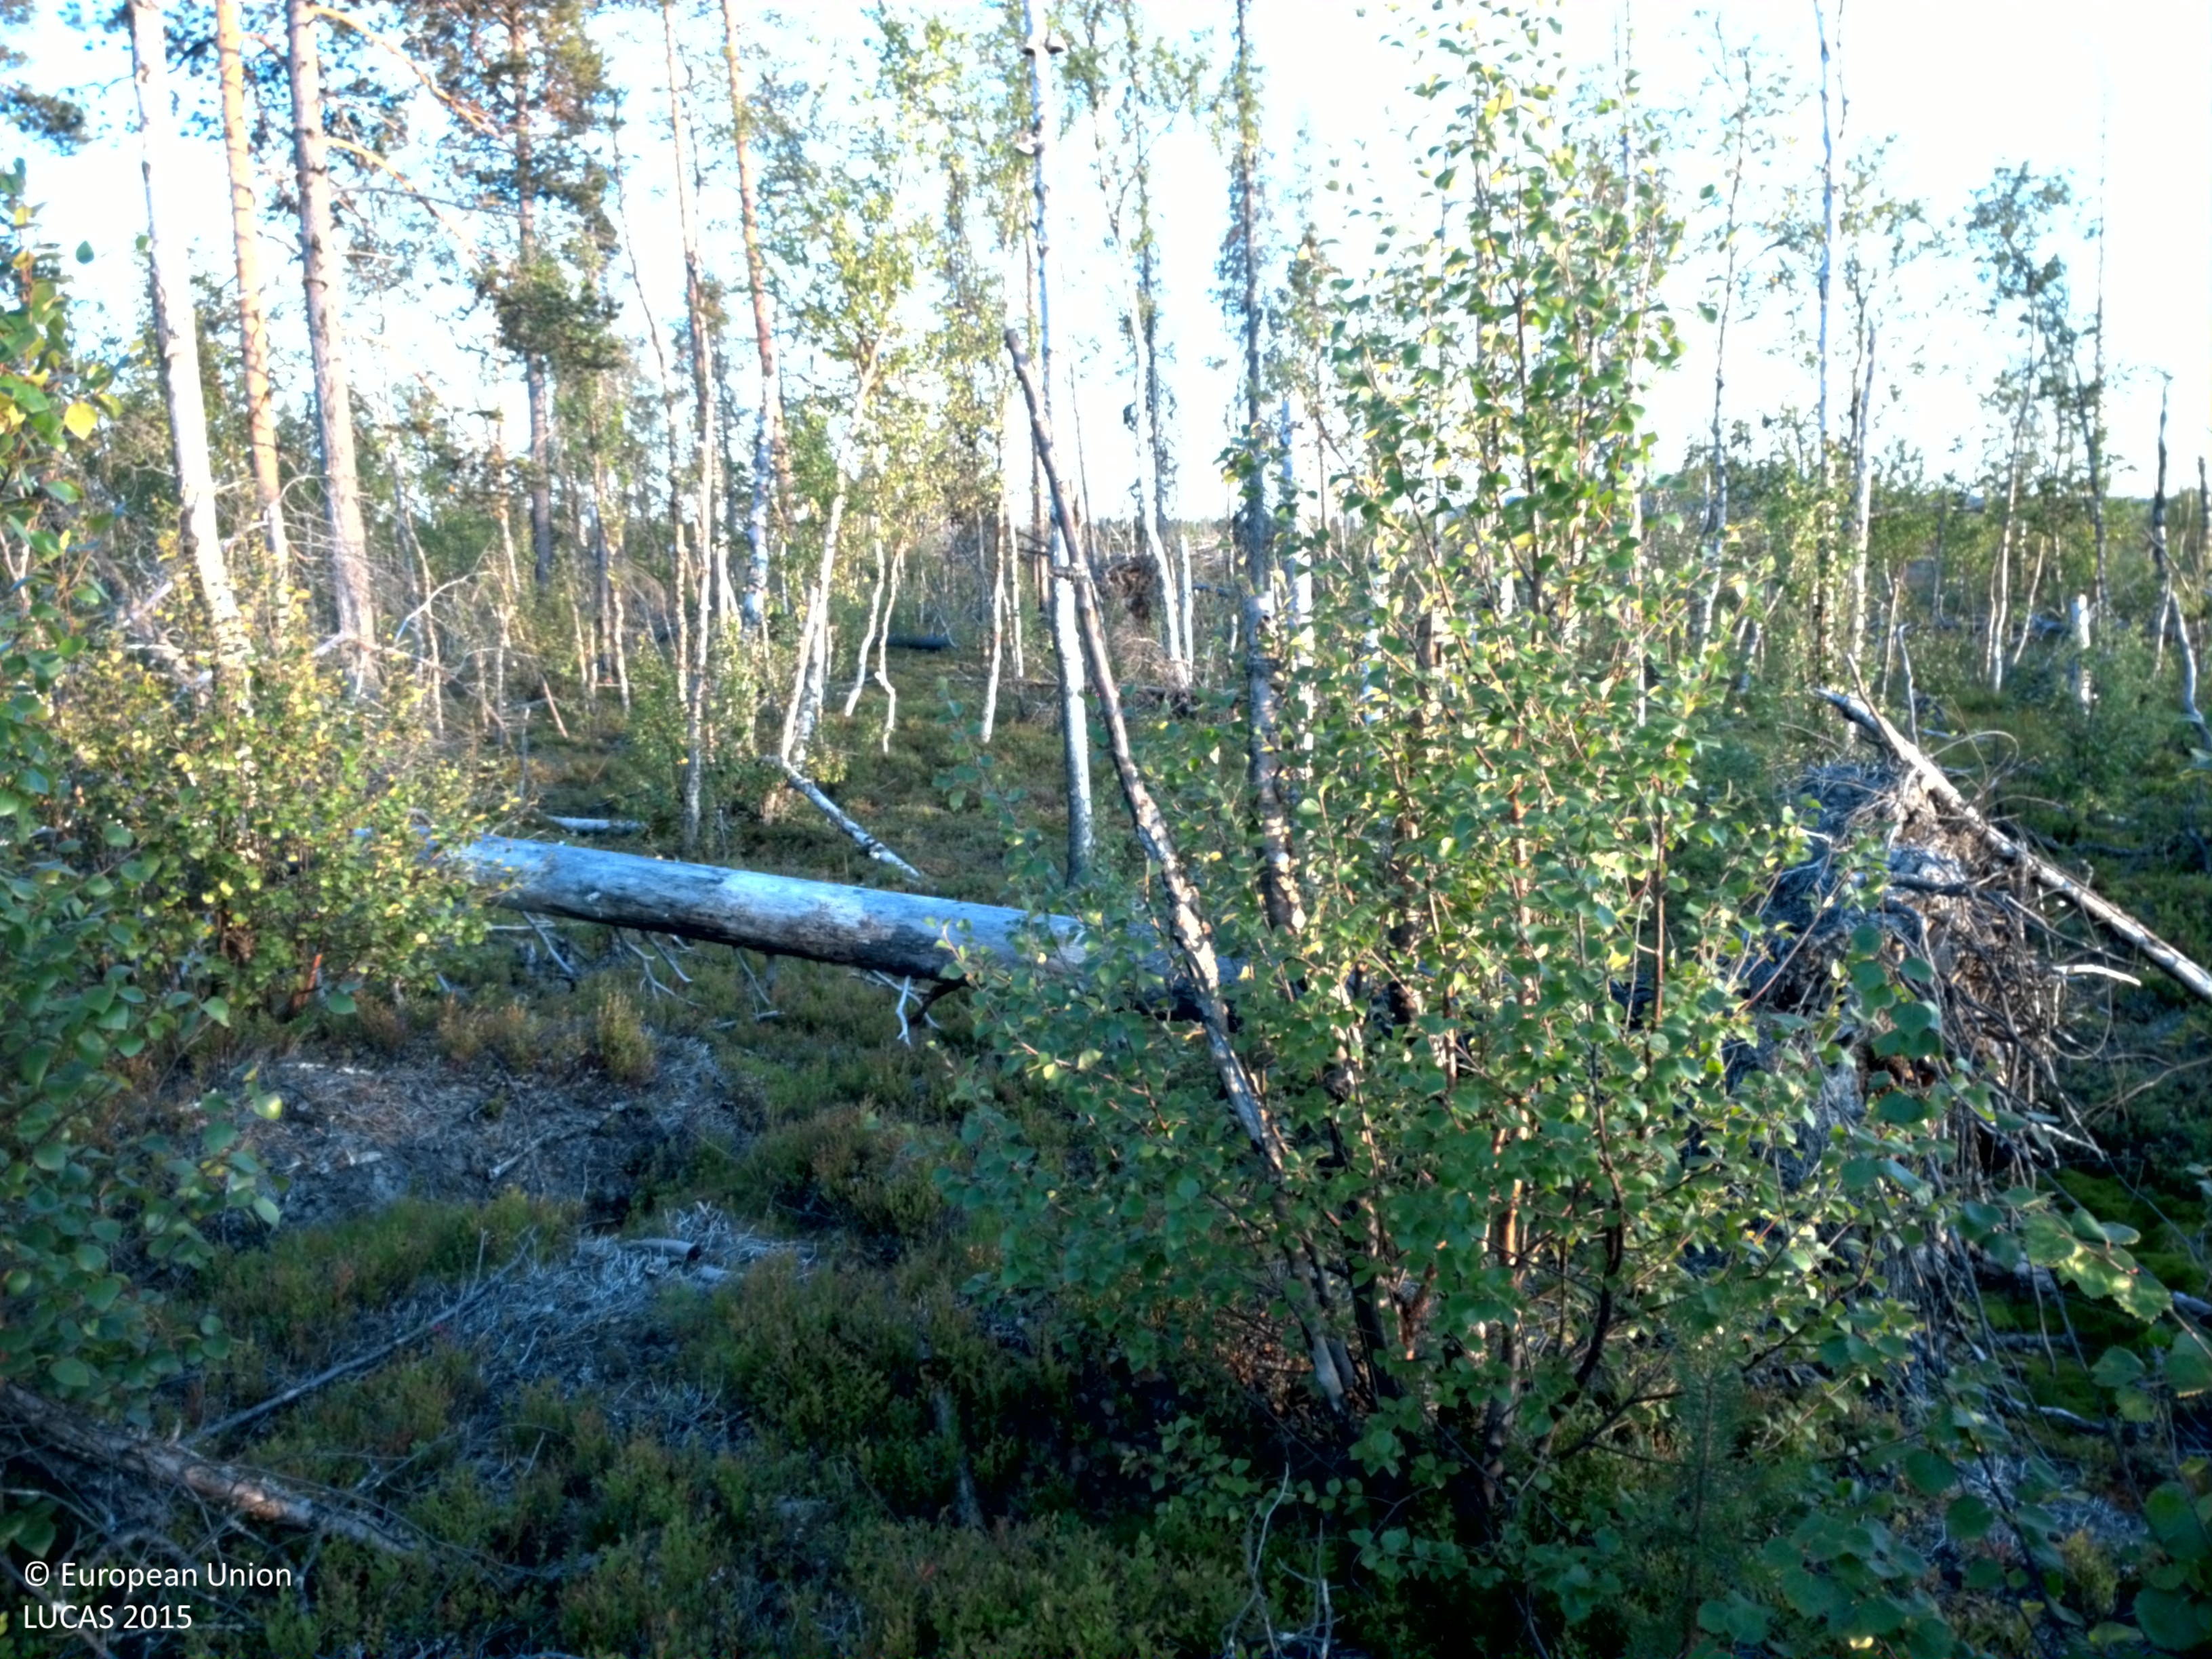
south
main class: Woodland
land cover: Broadleaved woodland
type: boreal forest
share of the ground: 10 - 25 %
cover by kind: shrubs 65 %, broadleaved forest trees 15 %, lichens and mosses 15 %
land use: Forestry
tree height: < 5 m
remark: Clear cut
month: August
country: SE
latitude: 66.6326
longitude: 19.1010
